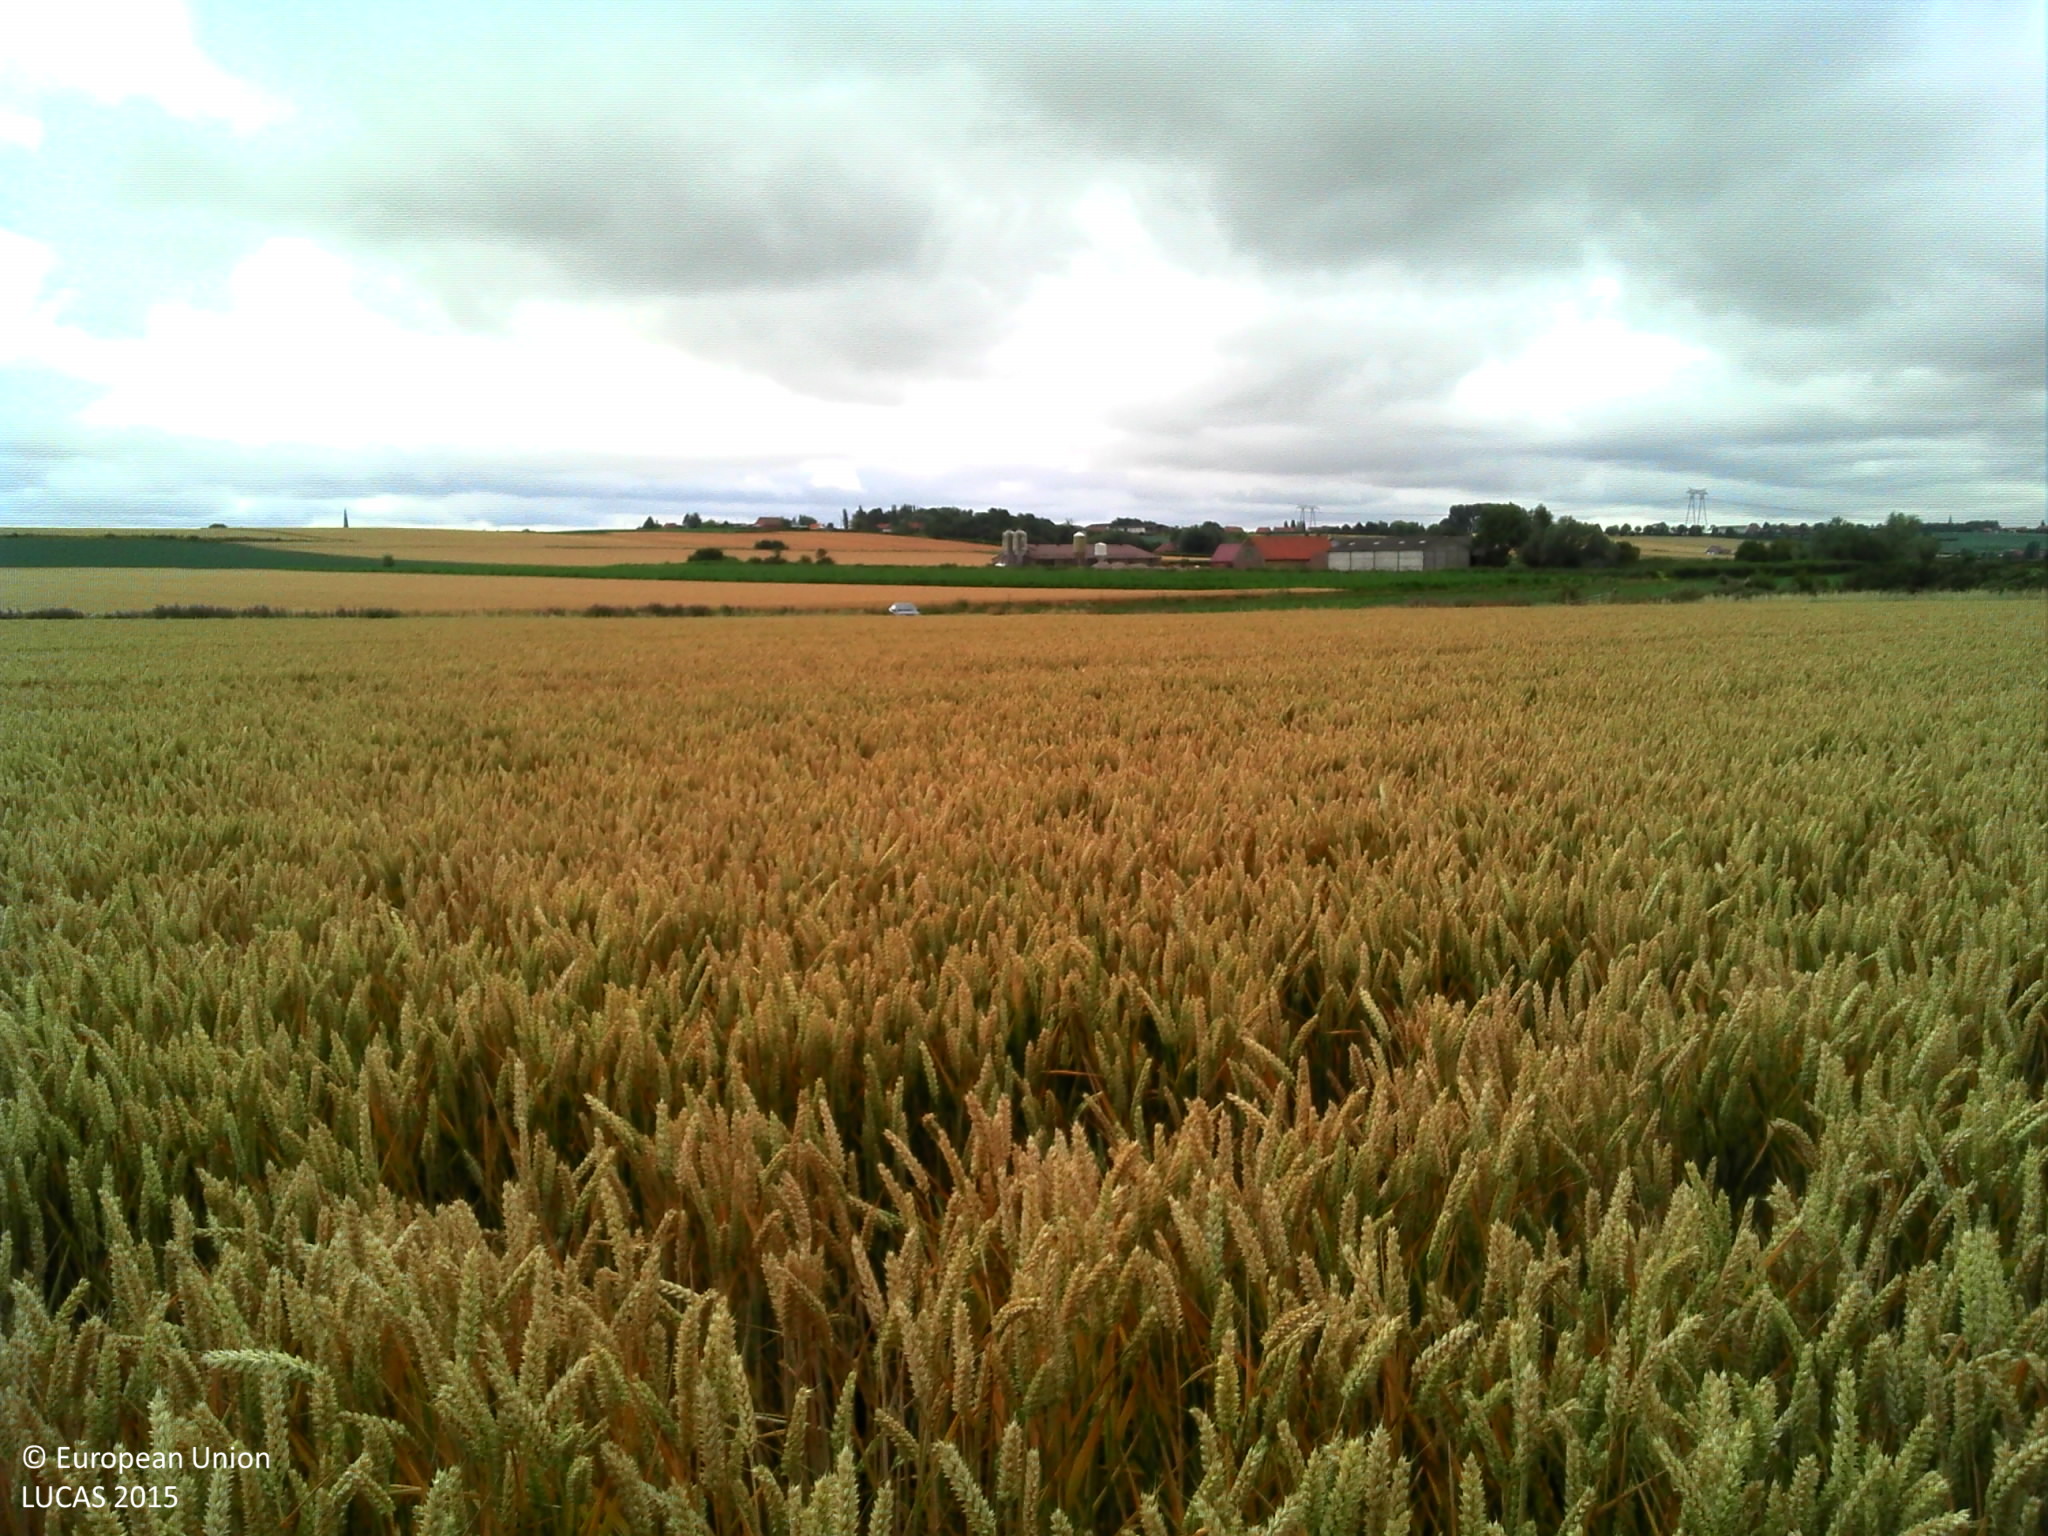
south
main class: Cropland
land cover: Common wheat
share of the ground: > 75 %
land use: Agriculture (excluding fallow land and kitchen gardens)
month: July
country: FR
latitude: 50.8827
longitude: 2.3250
